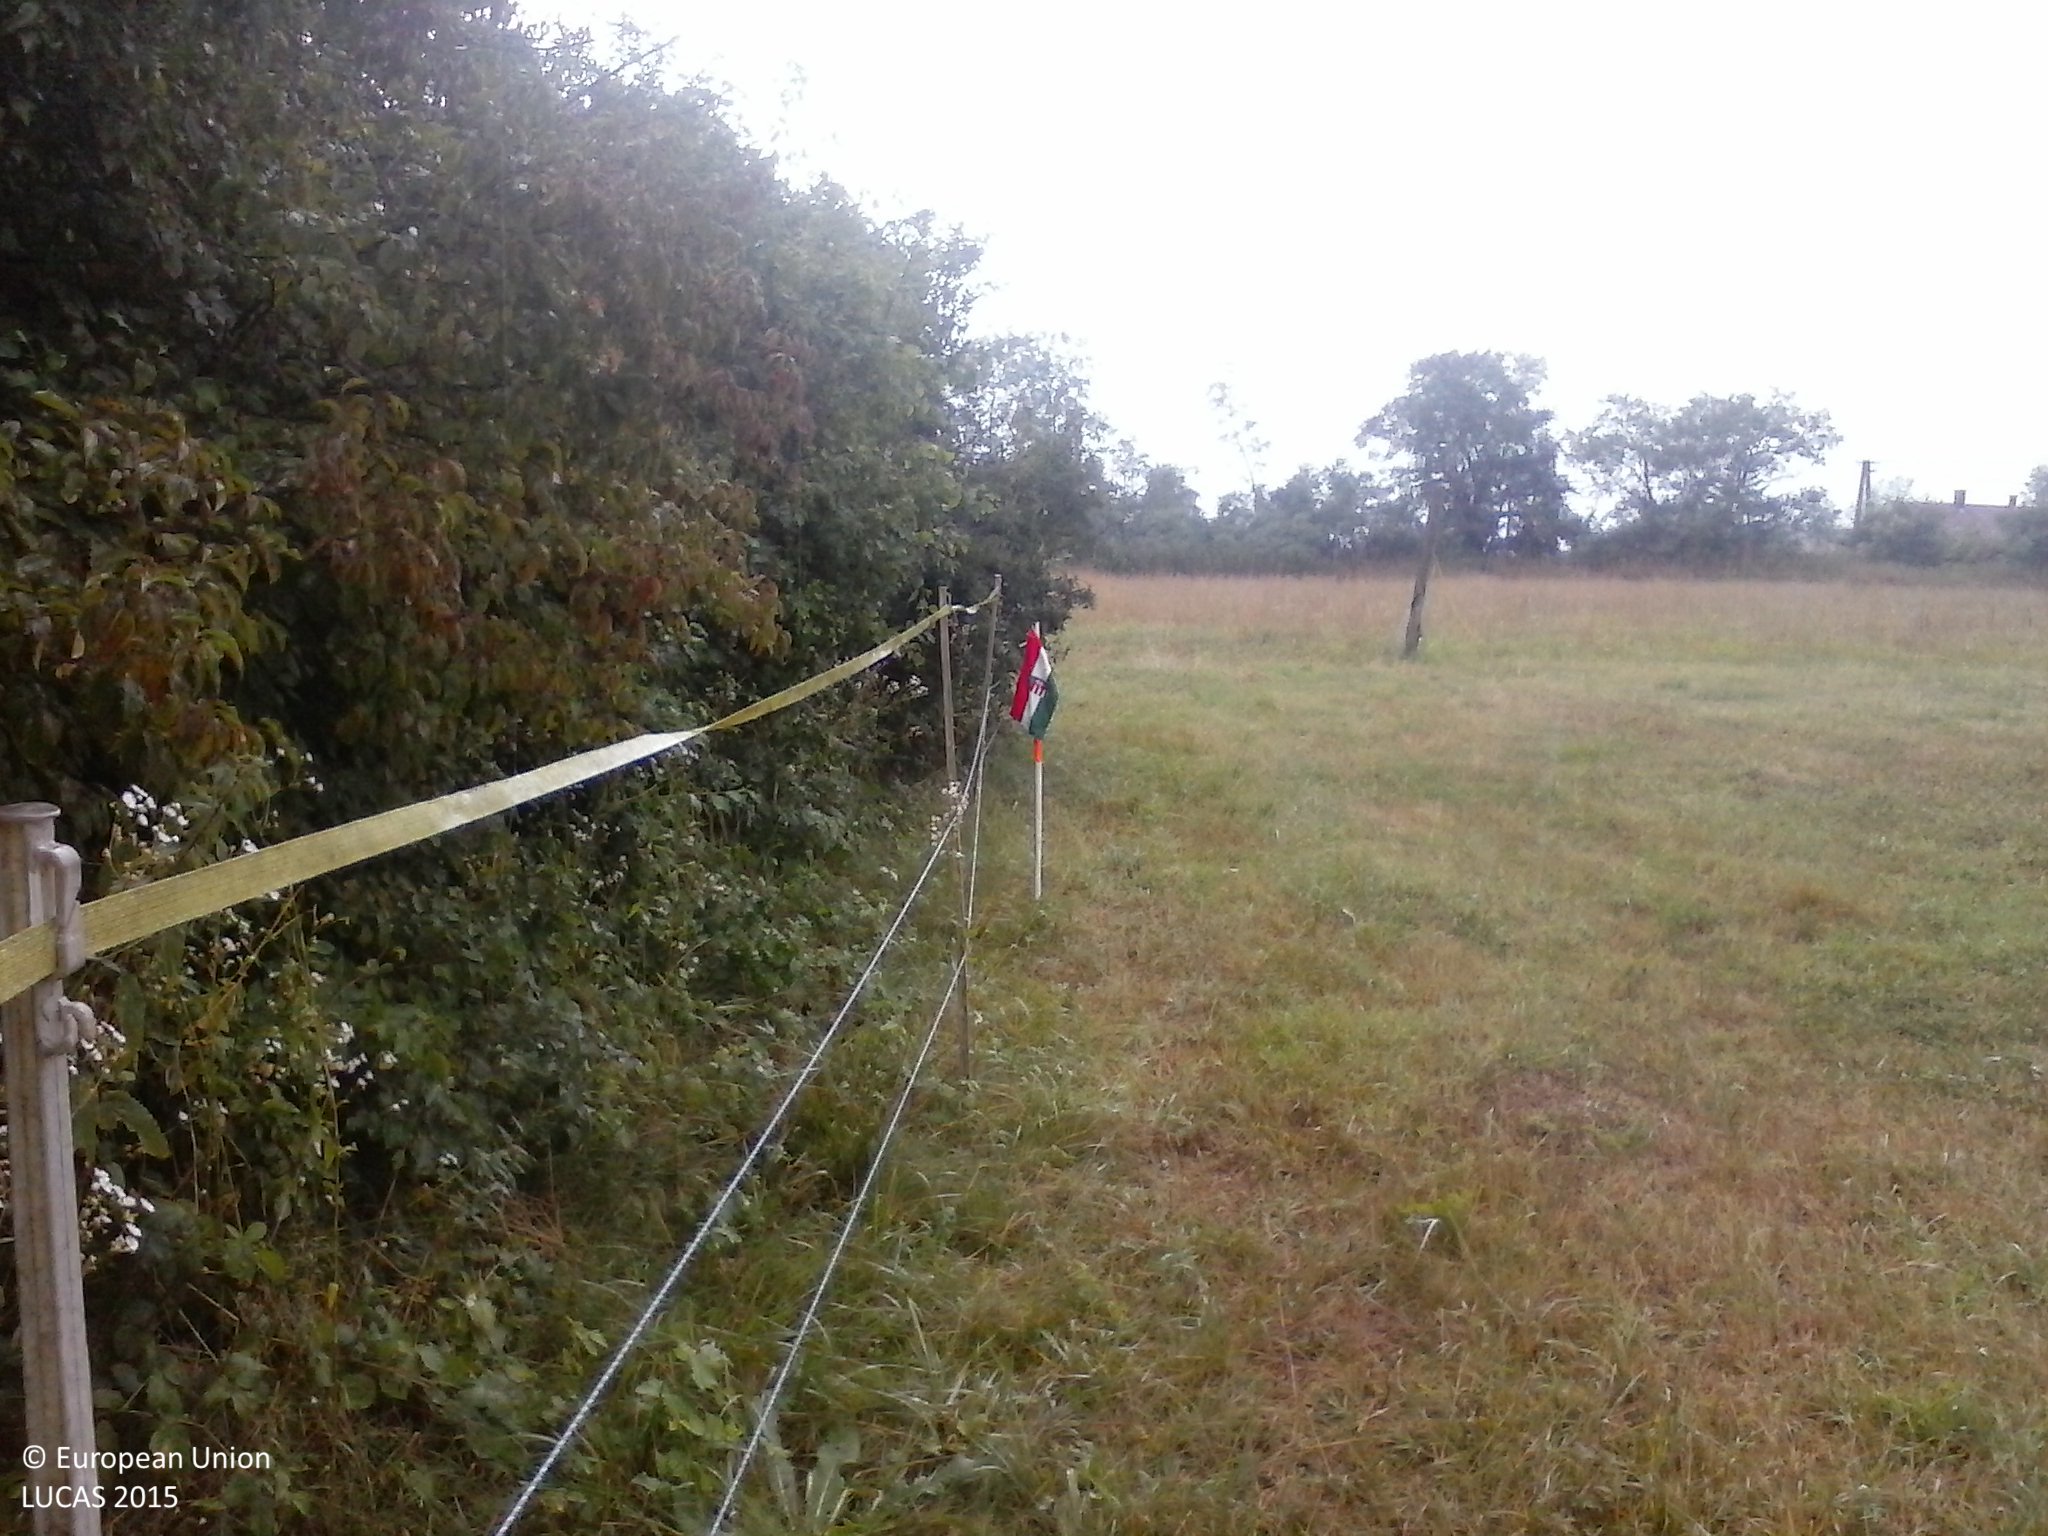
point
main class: Shrubland
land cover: Shrubland with sparse tree cover
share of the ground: > 75 %
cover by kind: shrubs 90 %, broadleaved forest trees 5 %, herbaceous plants 5 %
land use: Agriculture (excluding fallow land and kitchen gardens)
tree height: > 5 m
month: July
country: HU
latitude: 46.0359
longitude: 17.7181
